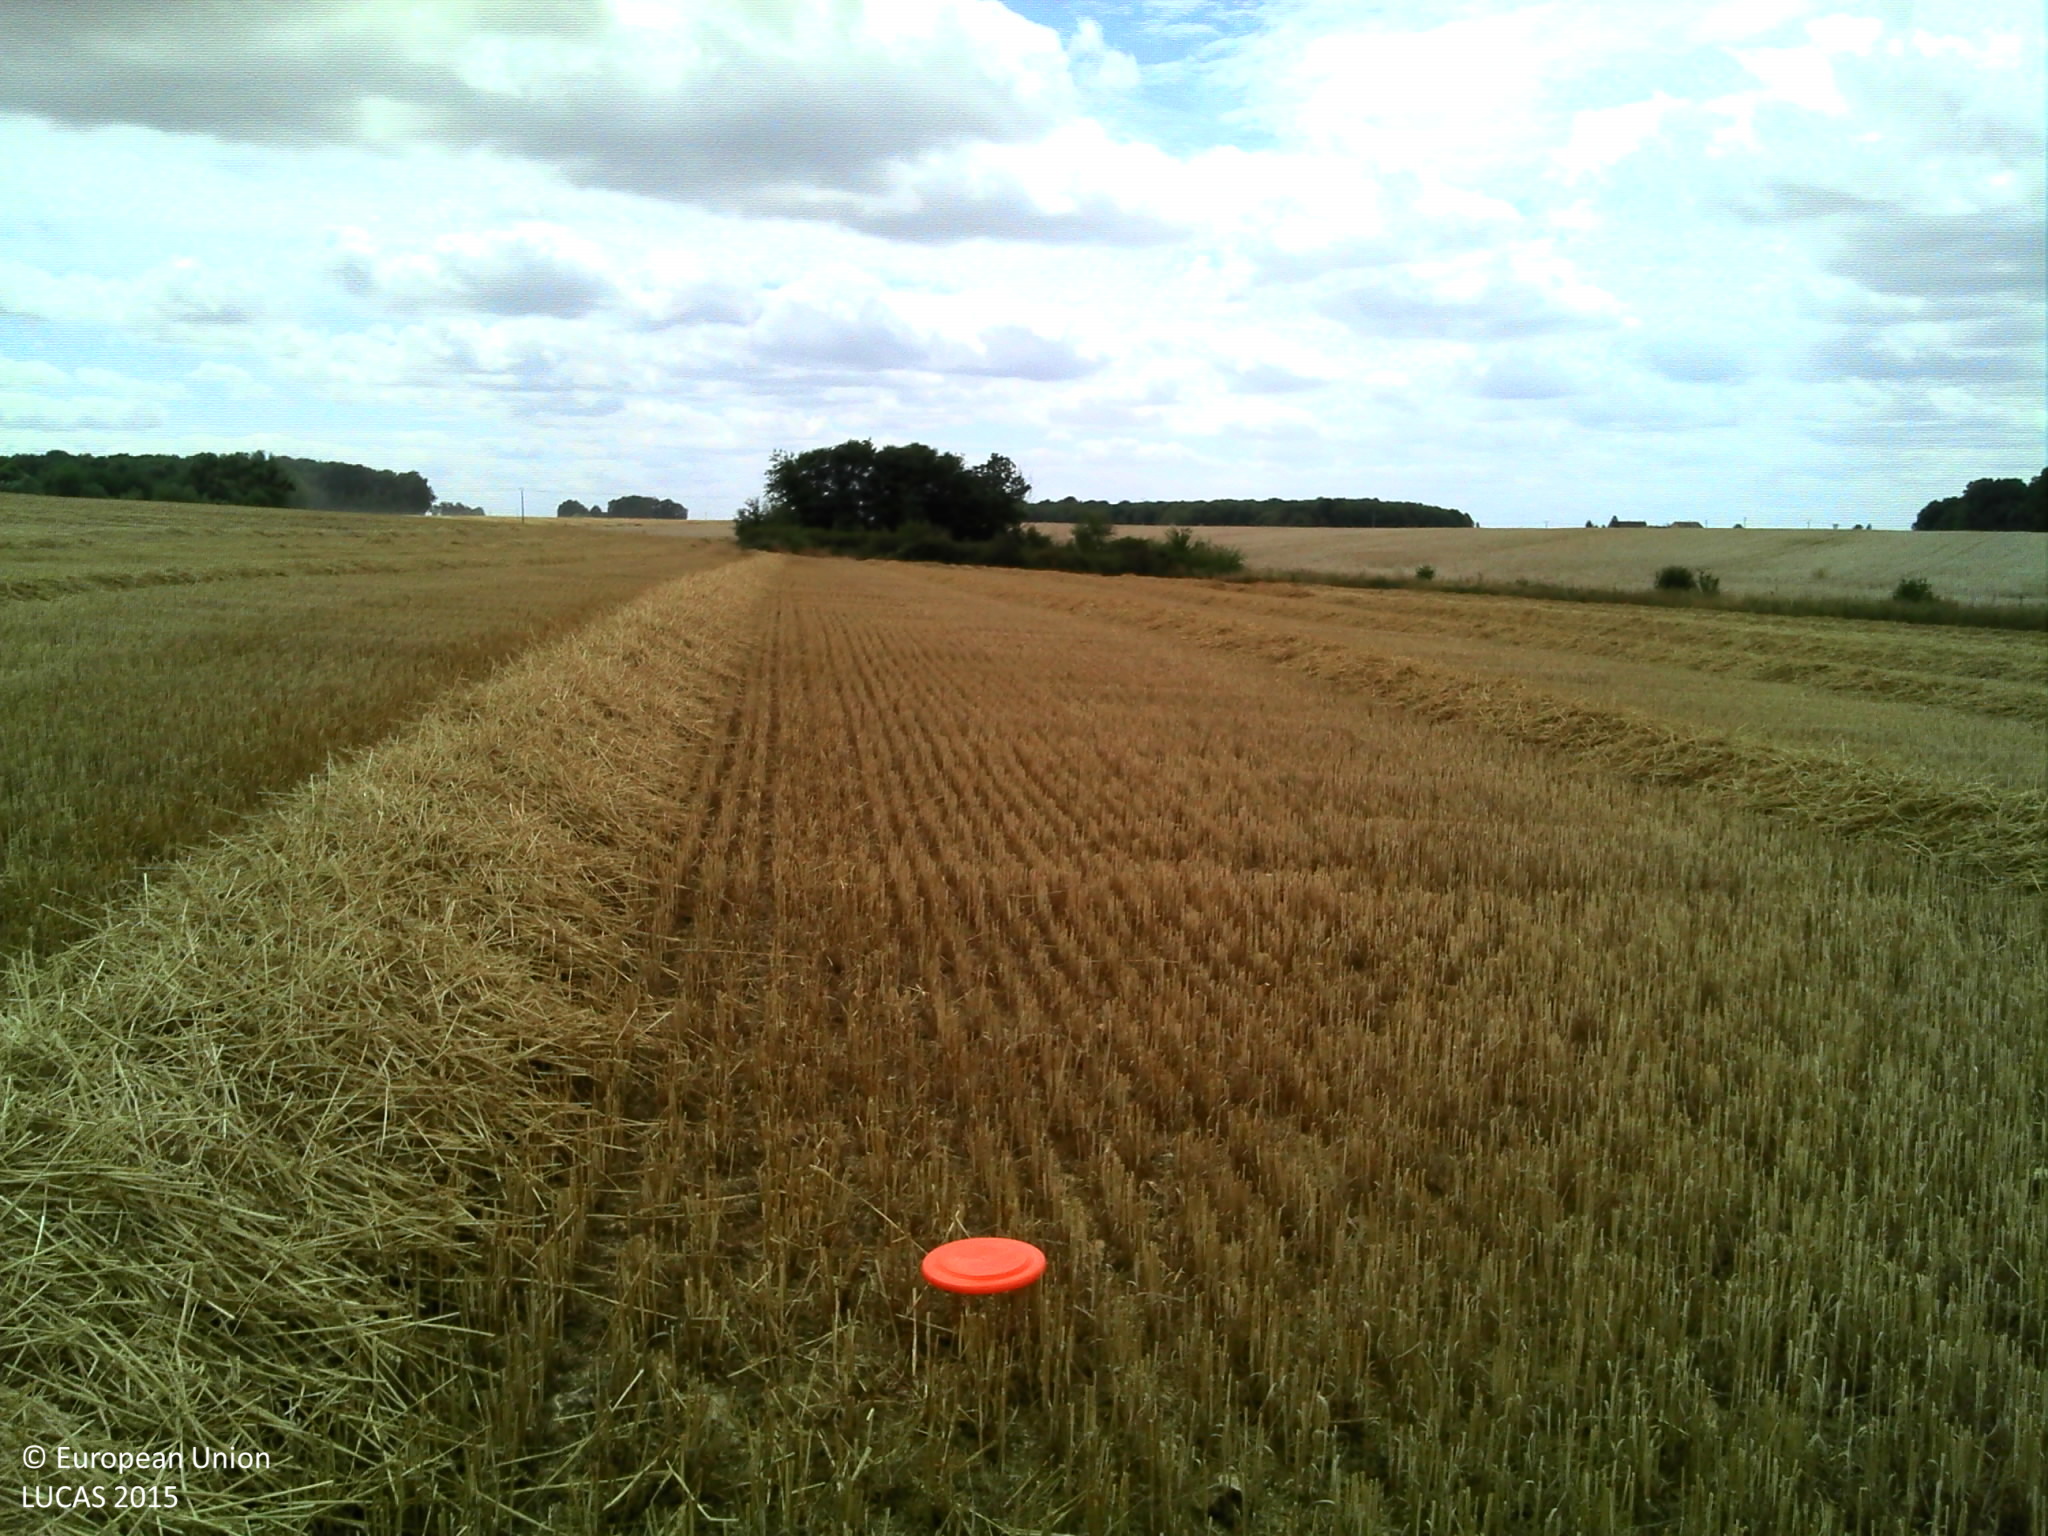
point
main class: Cropland
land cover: Common wheat
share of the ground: > 75 %
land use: Agriculture (excluding fallow land and kitchen gardens)
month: July
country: FR
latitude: 47.9009
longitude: 3.1313
